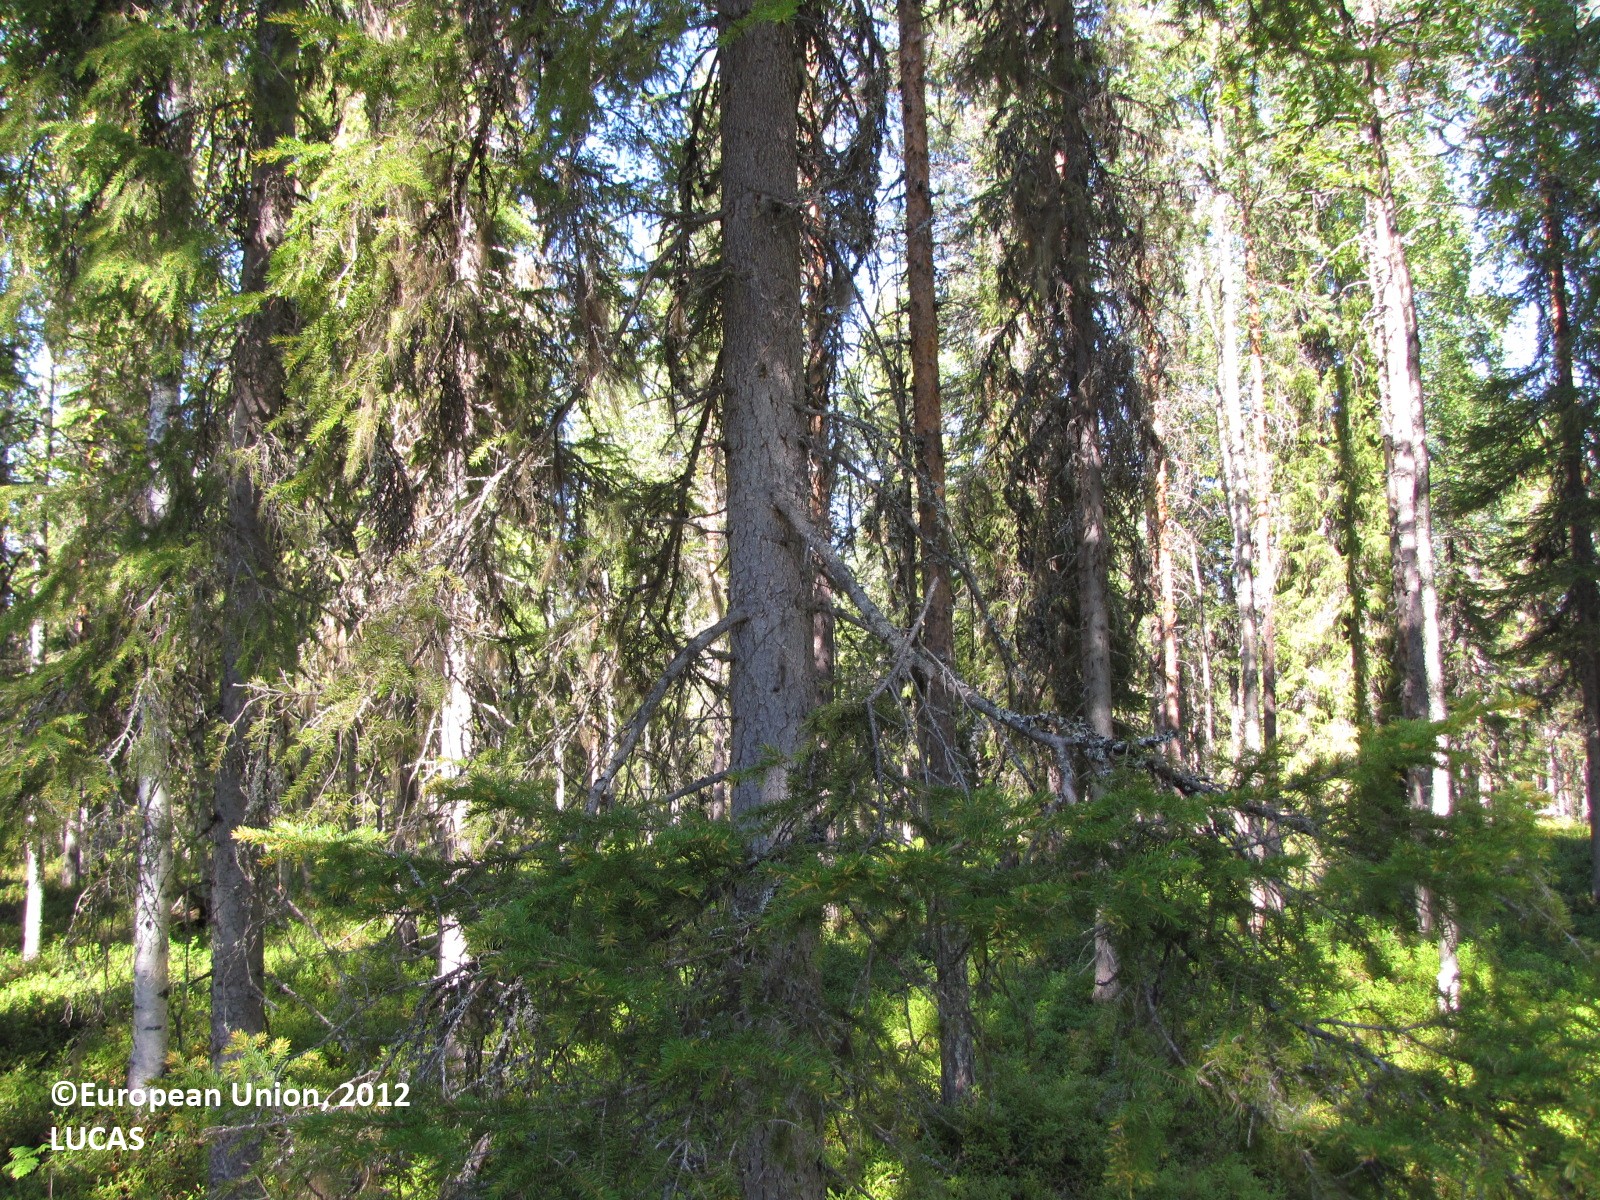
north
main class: Woodland
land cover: Other coniferous woodland
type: boreal forest
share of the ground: 50 - 75 %
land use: Forestry
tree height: > 5 m
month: August
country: FI
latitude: 66.9329
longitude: 25.2157
